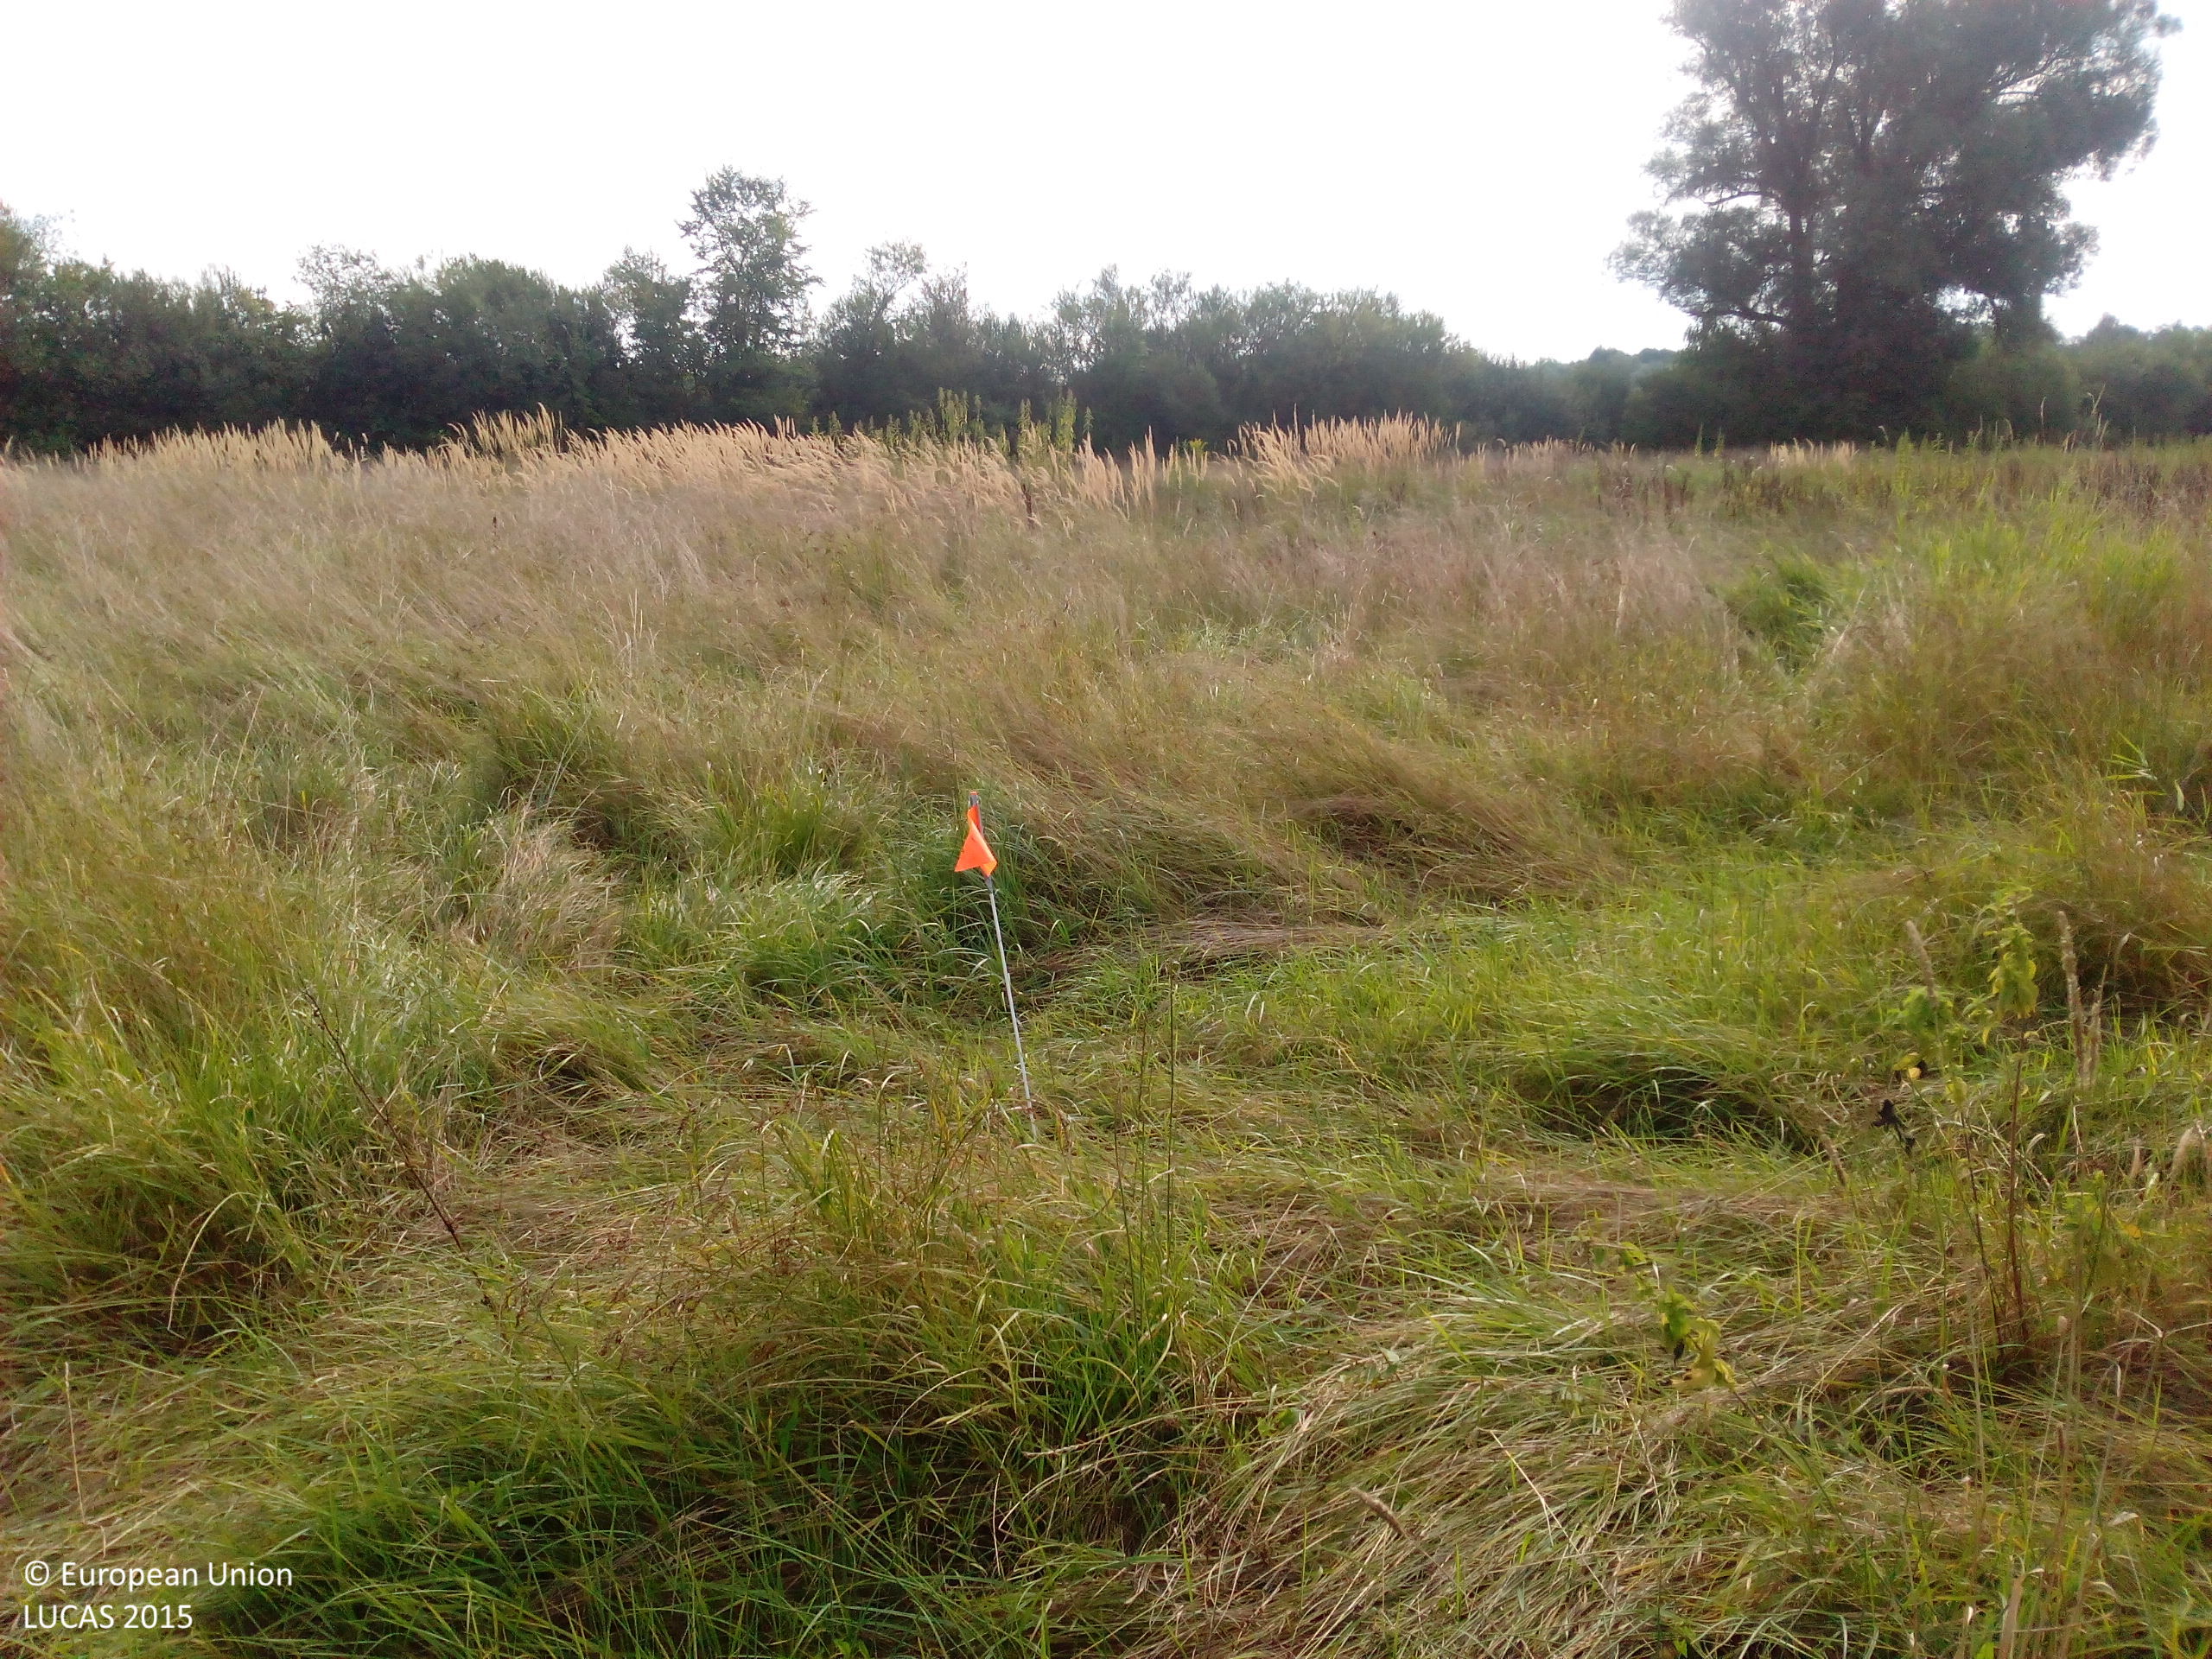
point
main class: Grassland
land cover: Grassland without tree/shrub cover
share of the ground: > 75 %
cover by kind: herbaceous plants 100 %
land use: Agriculture (excluding fallow land and kitchen gardens)
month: August
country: DE
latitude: 48.7782
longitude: 12.9525
